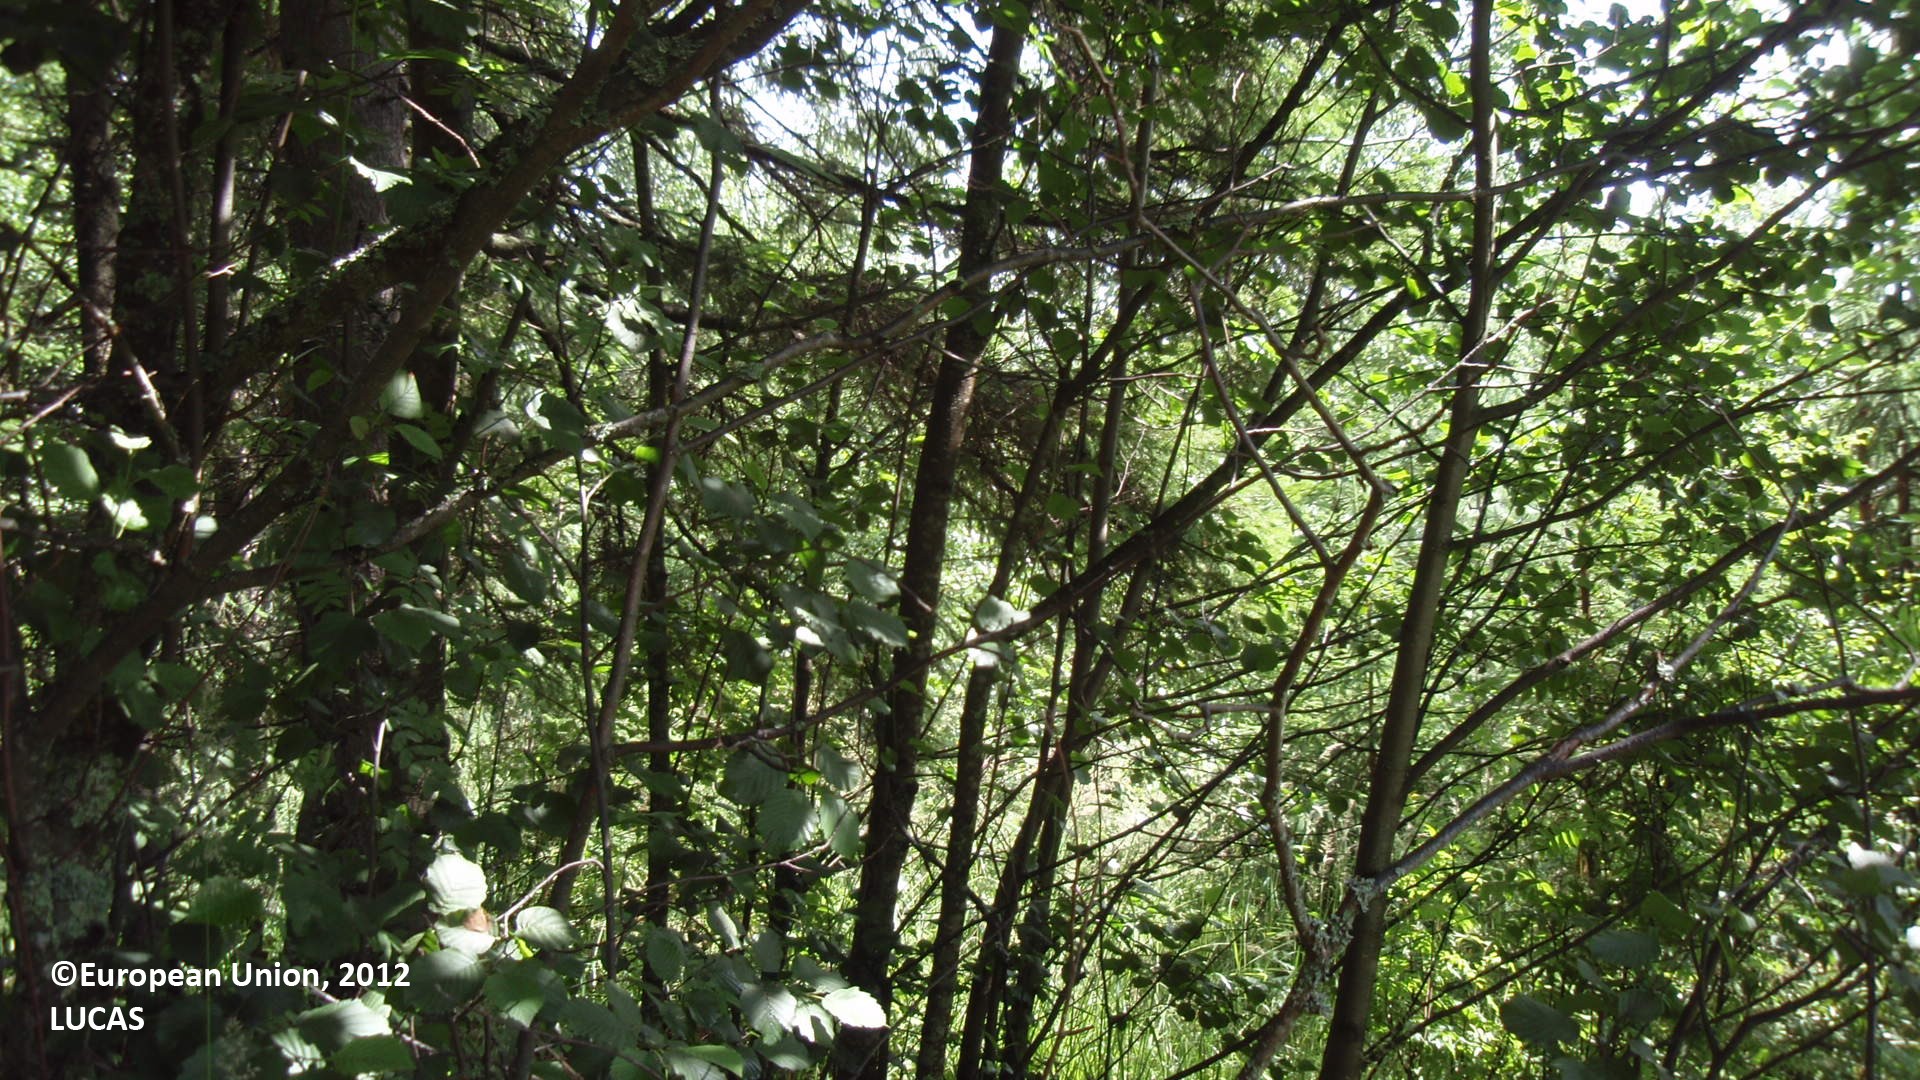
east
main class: Woodland
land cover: Spruce dominated coniferous woodland
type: boreal forest
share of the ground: 50 - 75 %
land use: Forestry
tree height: > 5 m
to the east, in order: Spruce dominated coniferous woodland; Spruce dominated mixed woodland; Ditches and canals; Broadleaved woodland; Shrubland with sparse tree cover; Rocks and stones; Railways; Rocks and stones; Spruce dominated mixed woodland; Shrubland with sparse tree cover
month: July
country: FI
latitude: 61.5111
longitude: 26.9427
